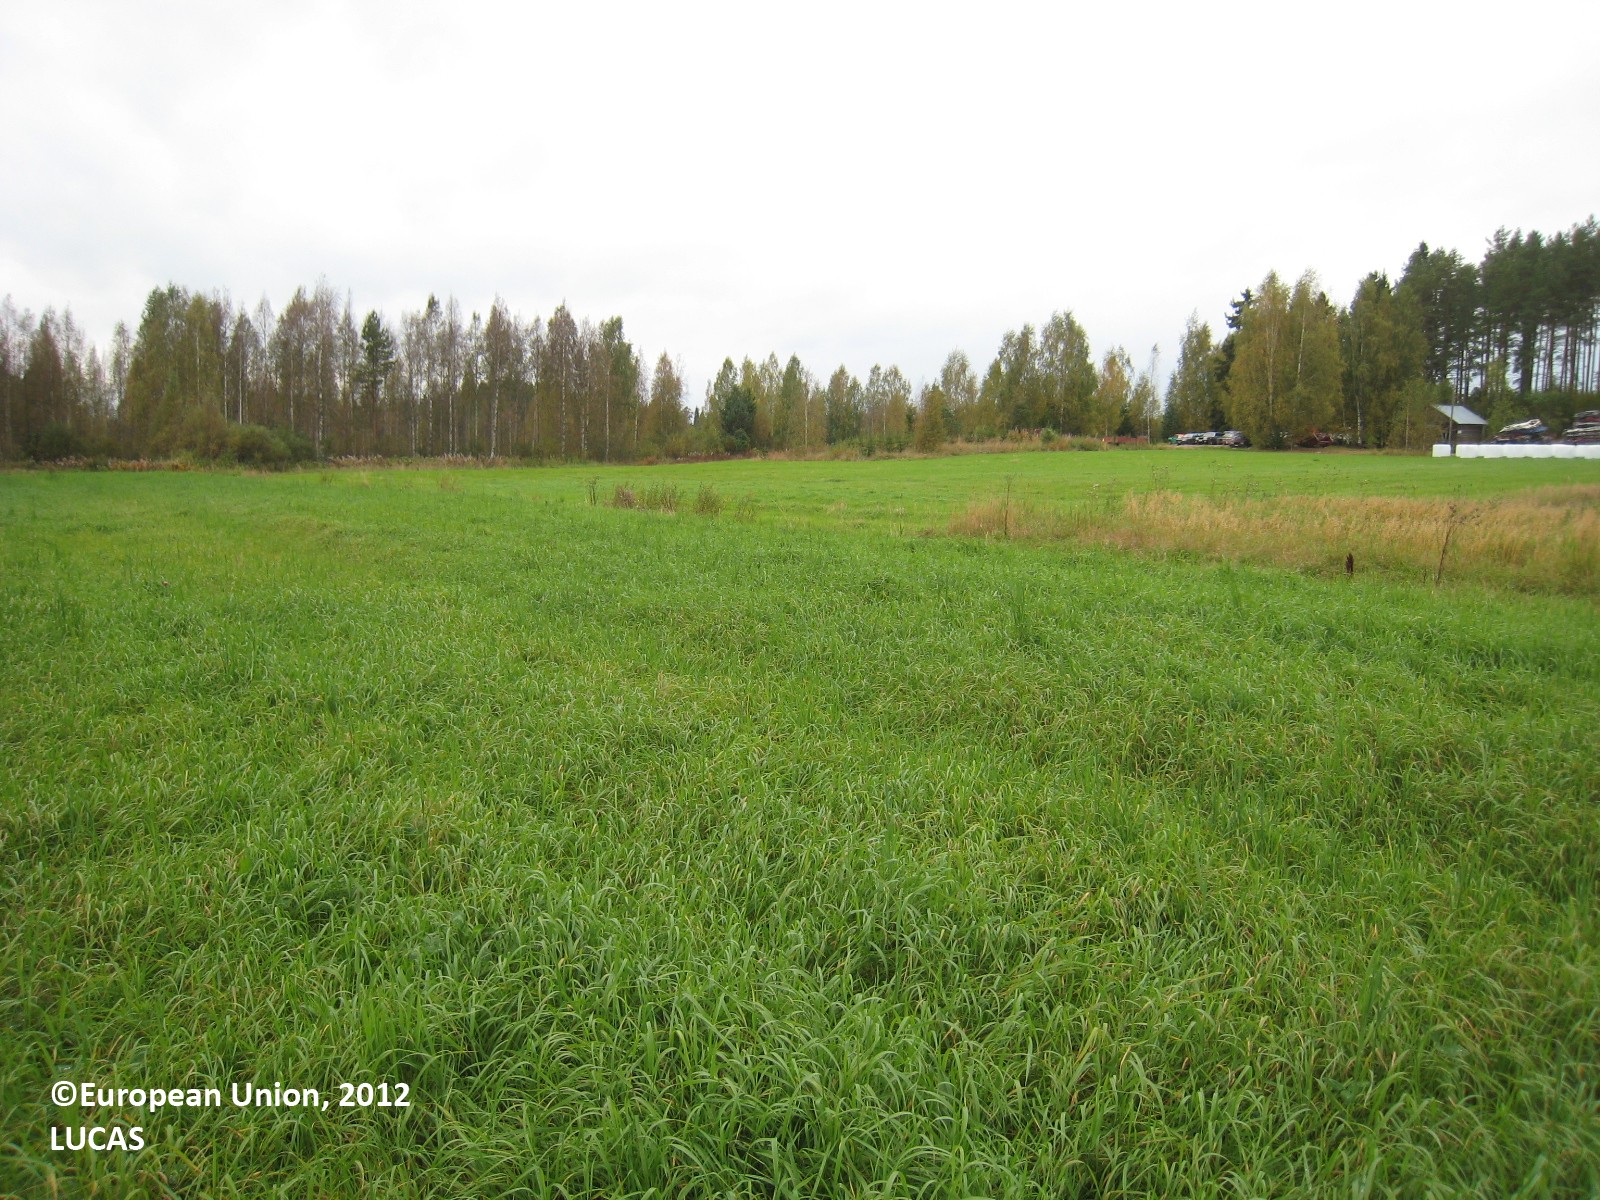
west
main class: Cropland
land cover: Temporary grasslands
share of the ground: > 75 %
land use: Agriculture (excluding fallow land and kitchen gardens)
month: September
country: FI
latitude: 62.7323
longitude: 26.6319
